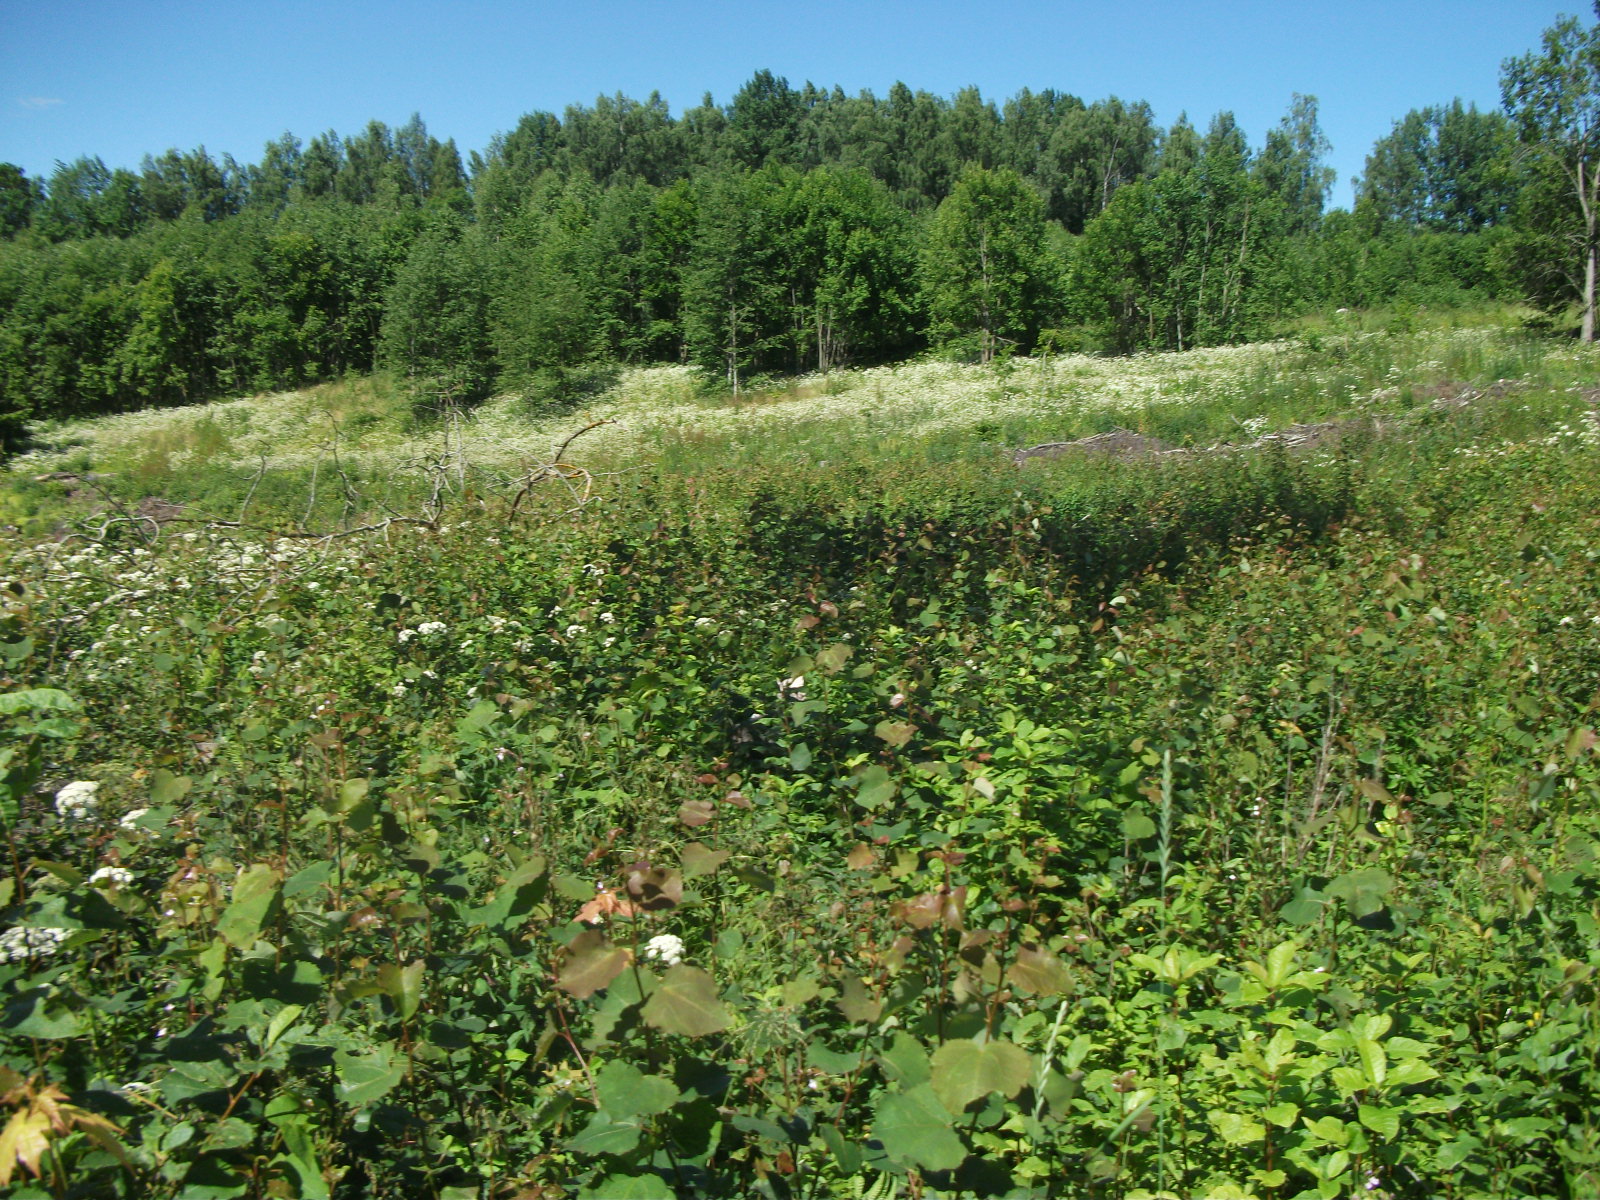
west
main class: Woodland
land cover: Broadleaved woodland
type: non-riverine alder, birch or aspen forest
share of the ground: 25 - 50 %
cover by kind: herbaceous plants 40 %, broadleaved forest trees 30 %, shrubs 25 %, lichens and mosses 5 %
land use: Forestry
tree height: < 5 m
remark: Clear cut
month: July
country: LV
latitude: 56.7894
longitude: 26.1632
